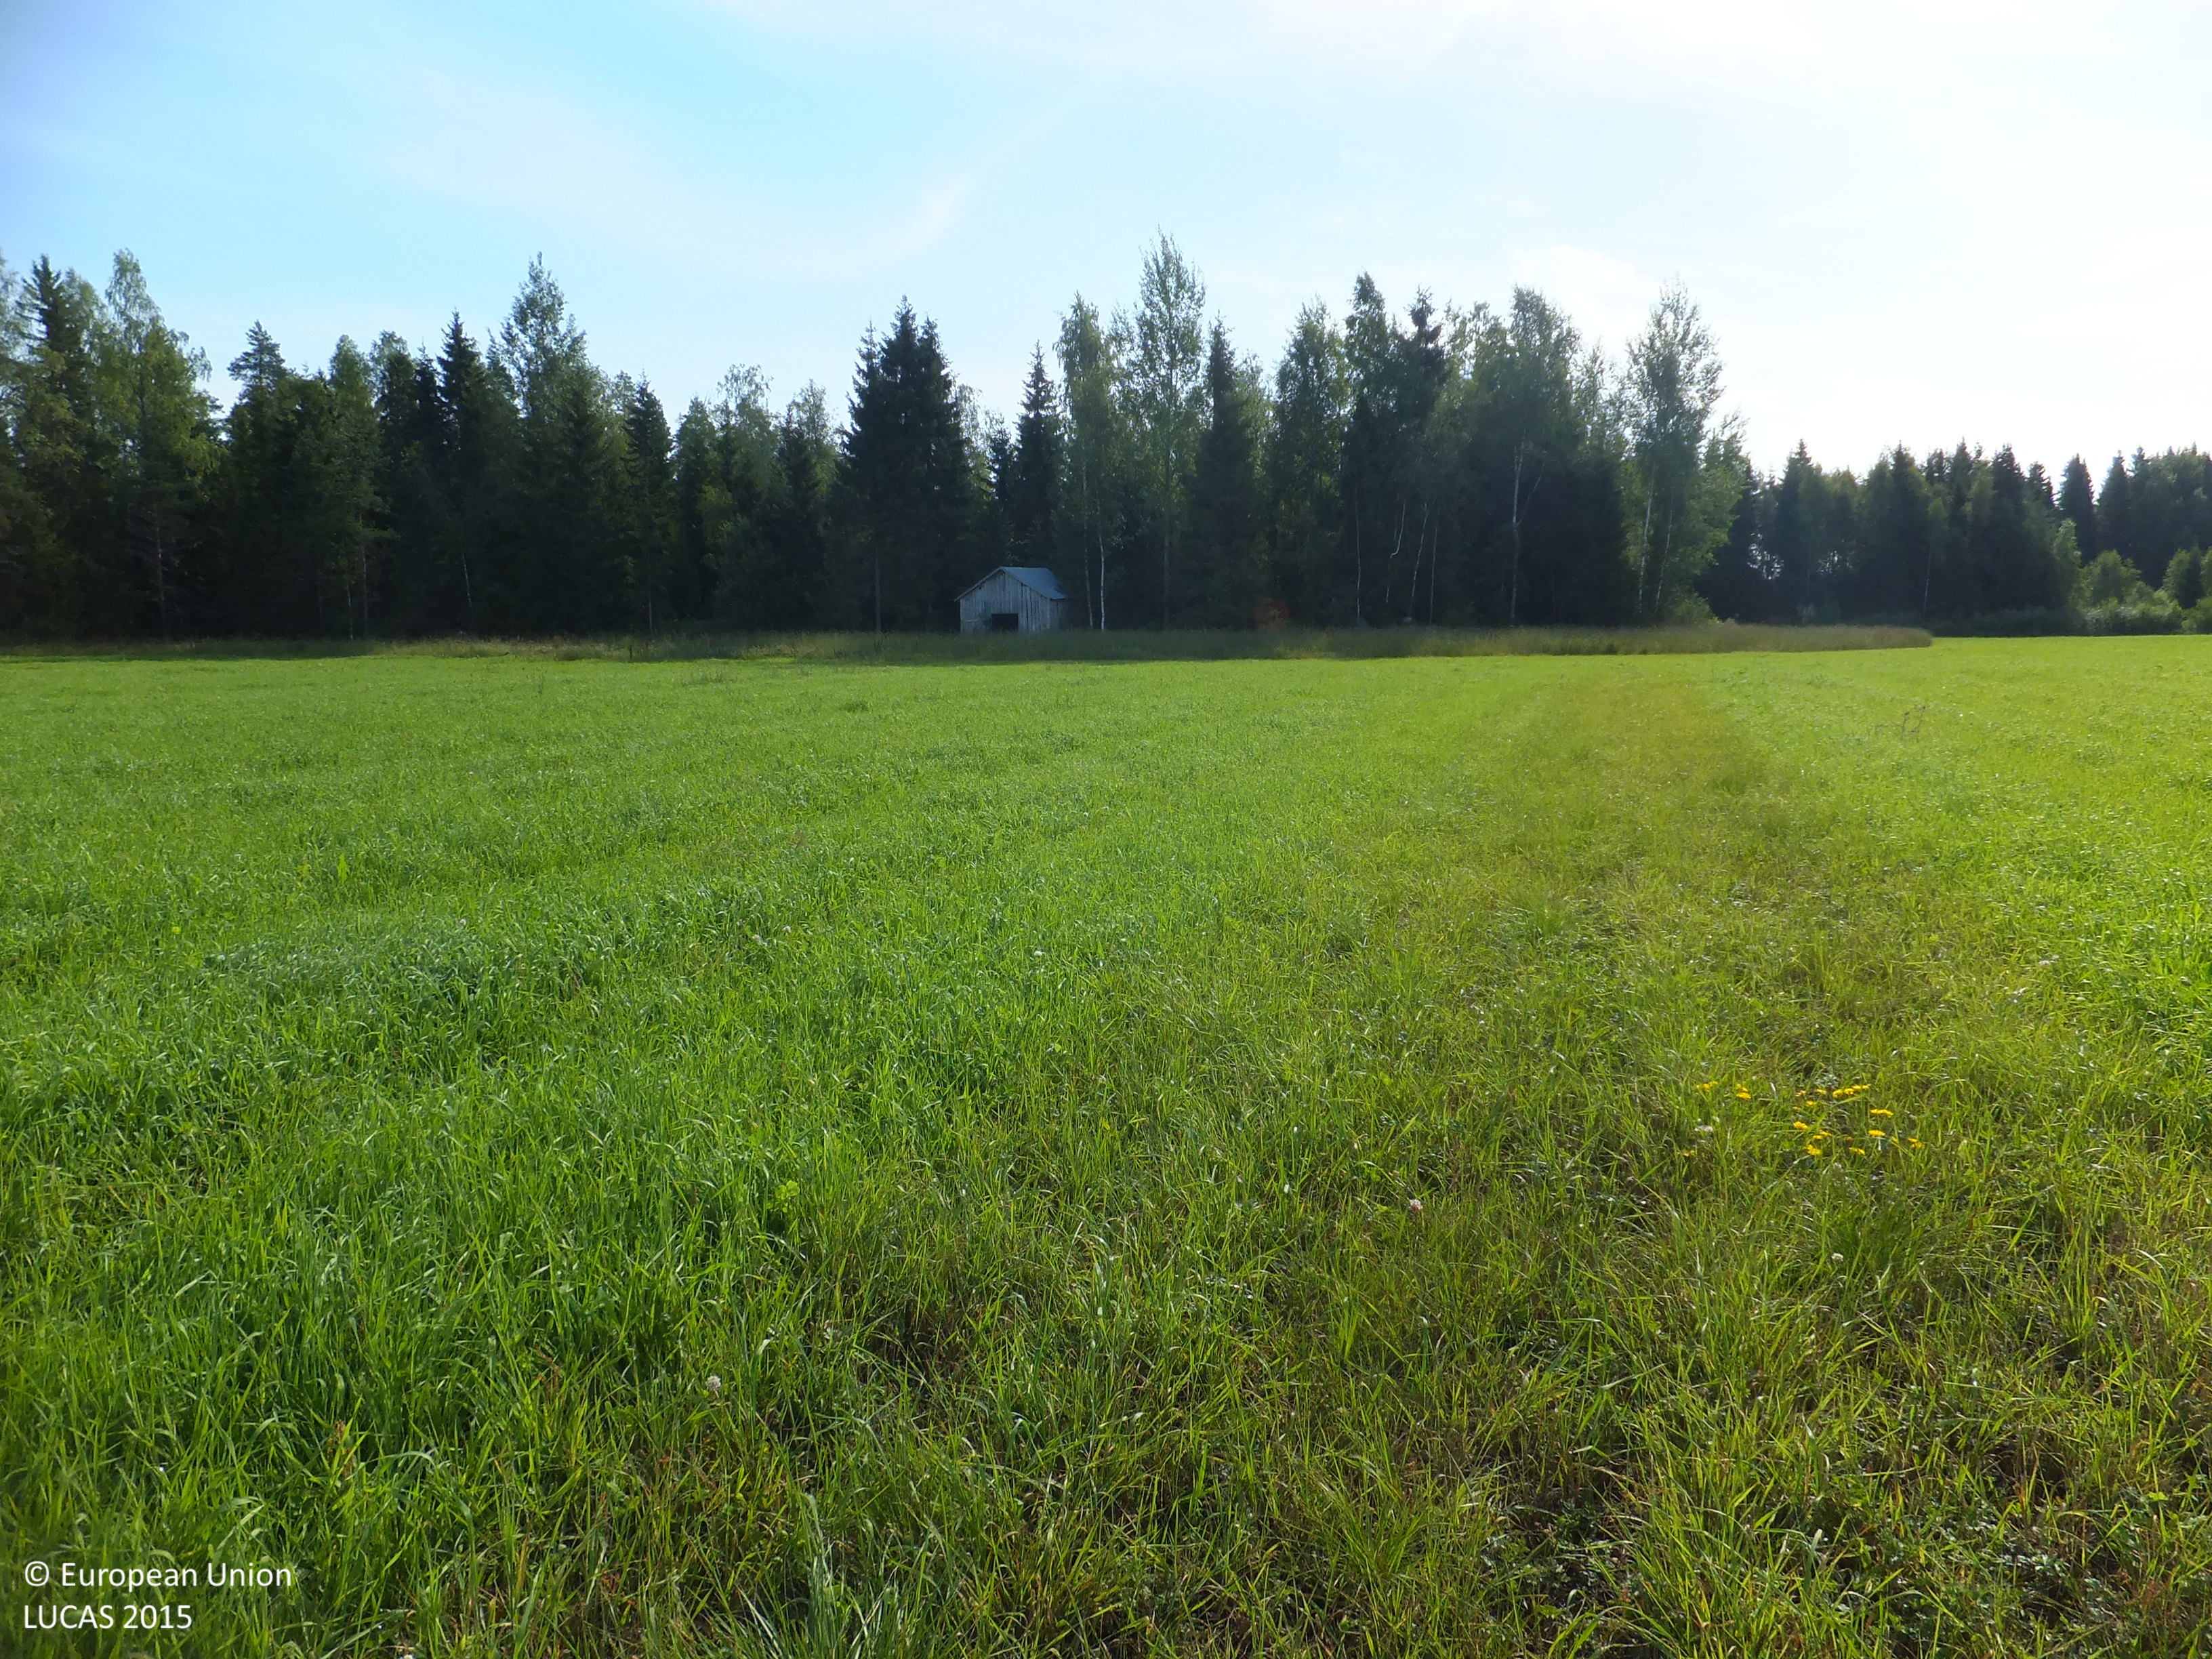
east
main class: Cropland
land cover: Temporary grasslands
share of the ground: > 75 %
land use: Agriculture (excluding fallow land and kitchen gardens)
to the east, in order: Temporary grasslands; Grass margins; Ditches and canals; Spruce dominated mixed woodland; Tracks; Spruce dominated mixed woodland
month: August
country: FI
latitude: 63.3761
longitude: 22.8743
